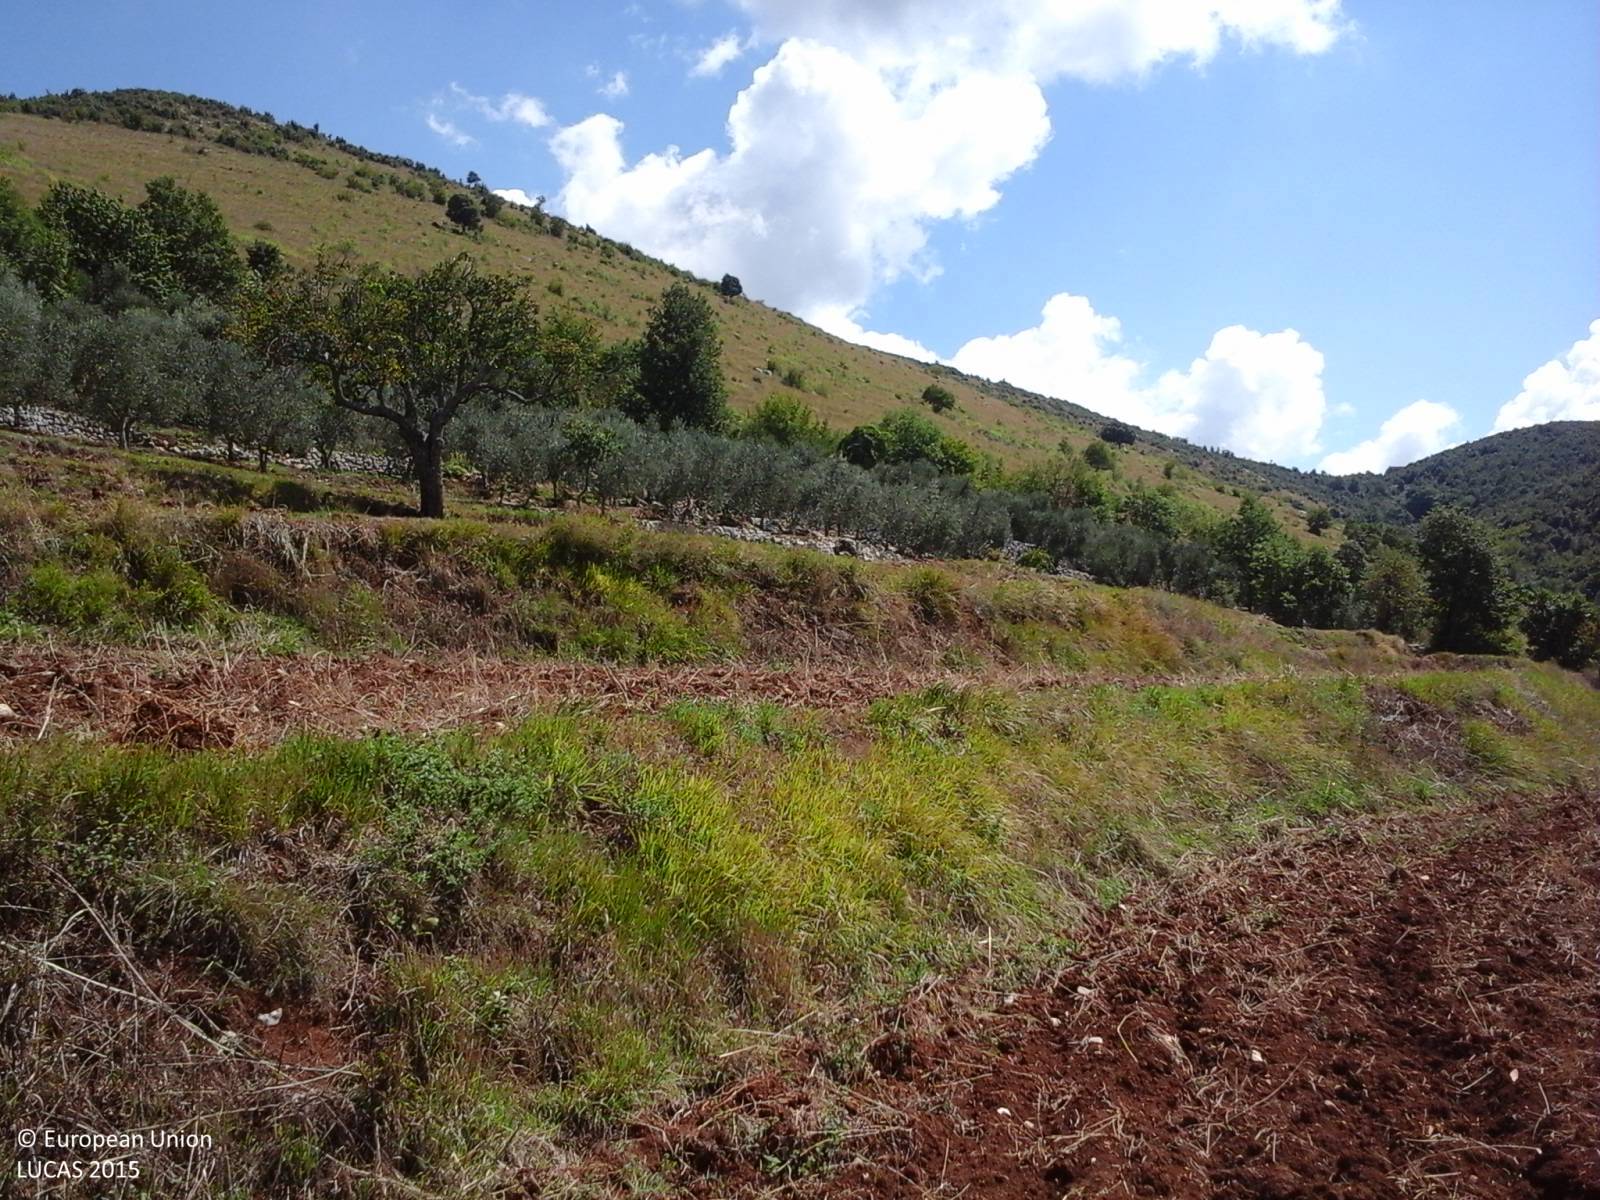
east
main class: Cropland
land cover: Temporary grasslands
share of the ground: < 10 %
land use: Agriculture (excluding fallow land and kitchen gardens)
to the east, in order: Temporary grasslands; Grass margins; Temporary grasslands; Single bushes/trees; Temporary grasslands; Dry stone walls; Olive groves; Dry stone walls; Abandoned hedges; Shrubland with sparse tree cover; Grassland without tree/shrub cover
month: August
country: IT
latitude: 41.4404
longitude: 13.3739
